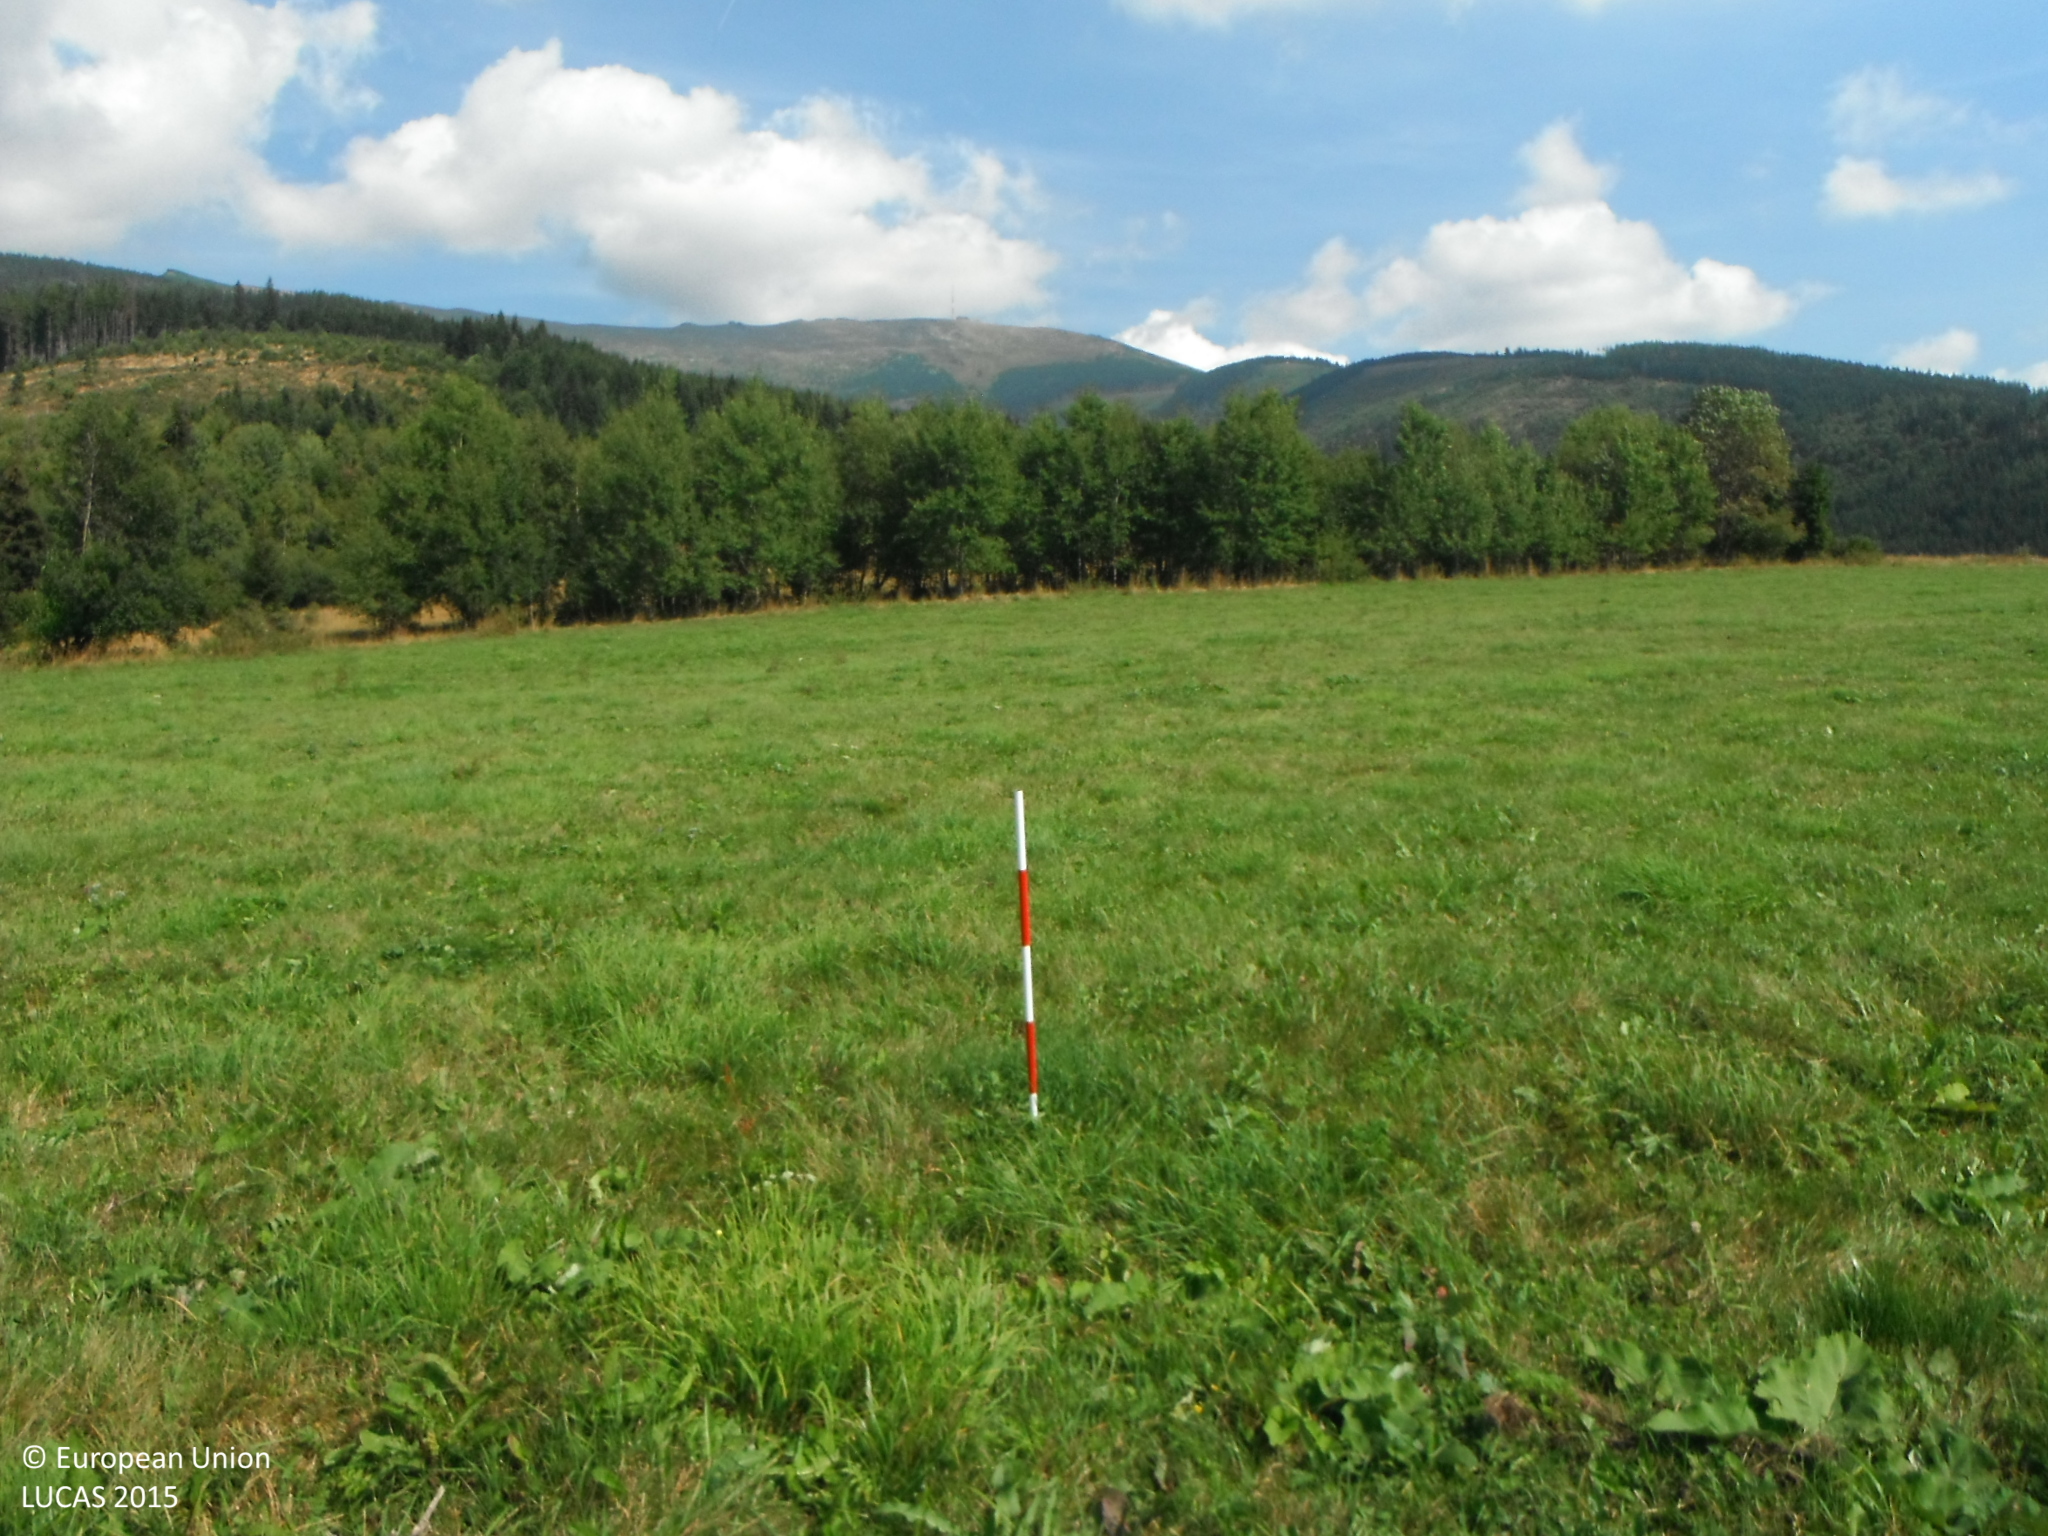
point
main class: Grassland
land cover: Grassland without tree/shrub cover
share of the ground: > 75 %
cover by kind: herbaceous plants 100 %
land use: Agriculture (excluding fallow land and kitchen gardens)
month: August
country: SK
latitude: 48.8462
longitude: 20.1017
